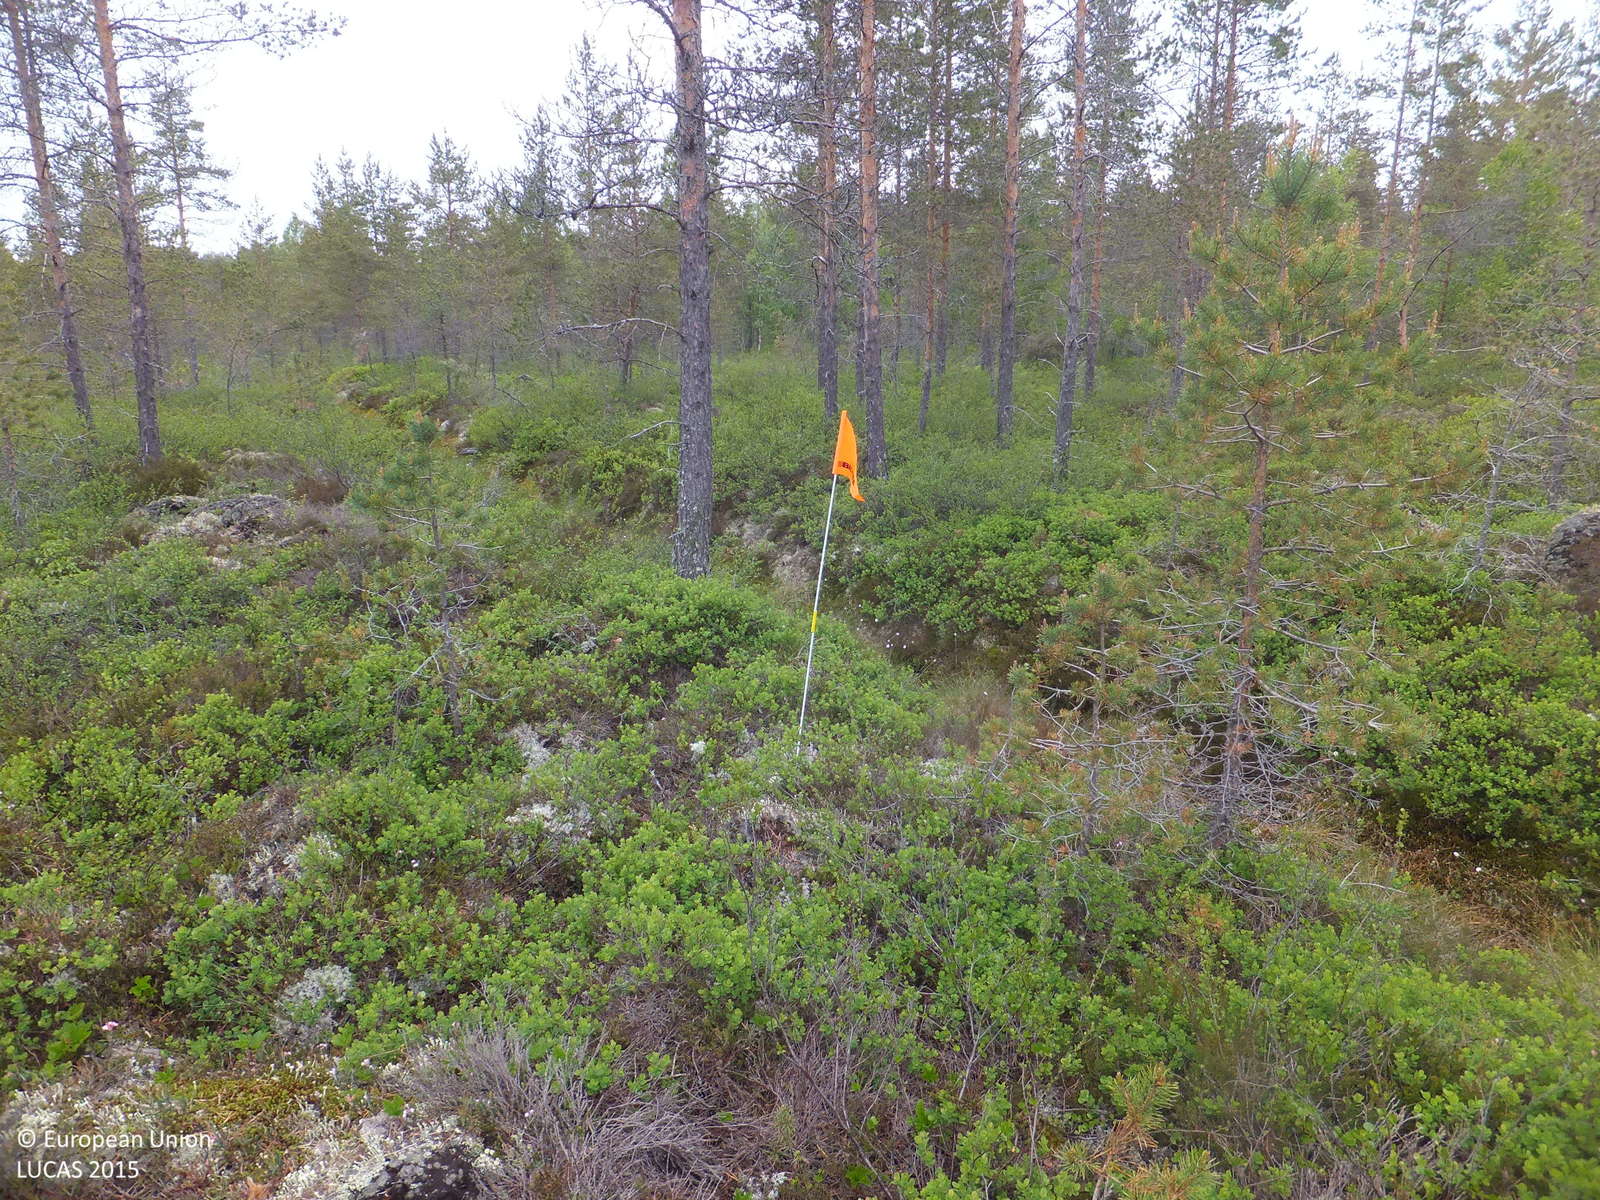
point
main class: Woodland
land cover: Pine dominated coniferous woodland
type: boreal forest
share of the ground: 25 - 50 %
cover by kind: coniferous forest trees 40 %, shrubs 40 %, herbaceous plants 20 %
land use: Forestry
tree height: > 5 m
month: June
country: FI
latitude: 63.6461
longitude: 24.1859
